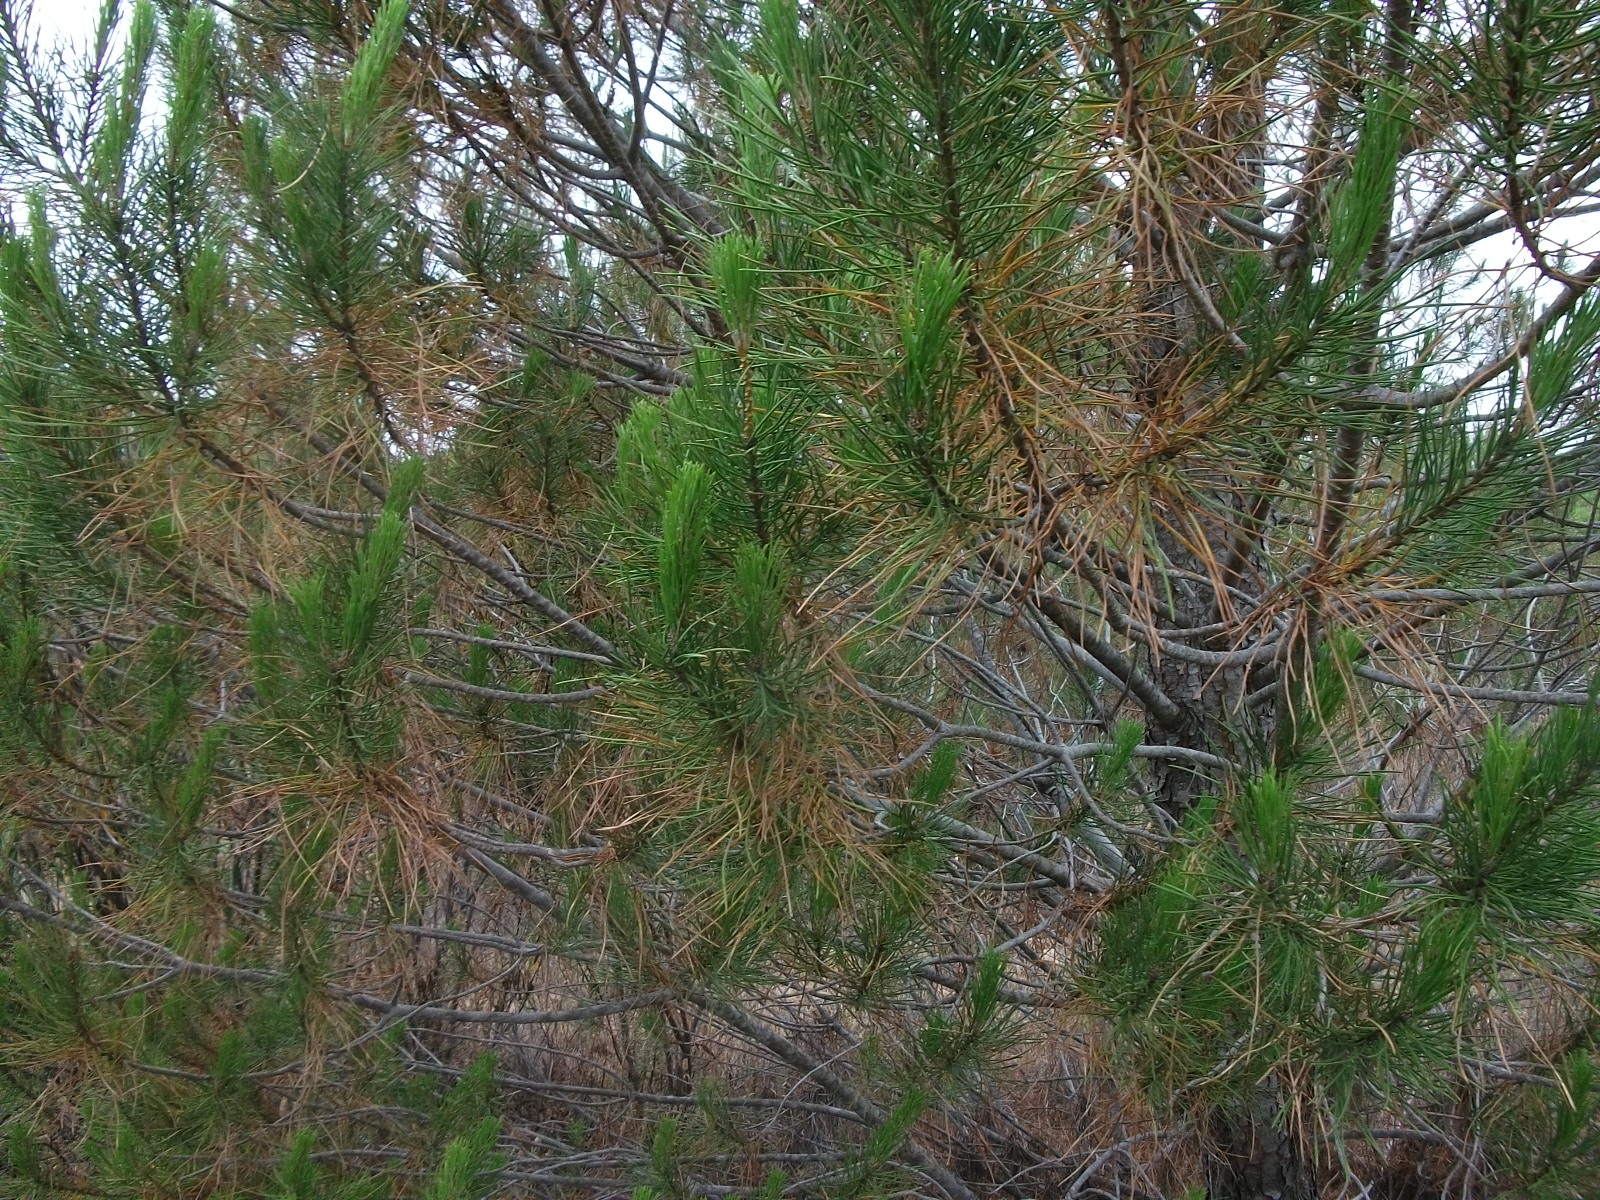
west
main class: Woodland
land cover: Pine dominated coniferous woodland
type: coniferous forest of the mediterranean region
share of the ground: 50 - 75 %
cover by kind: coniferous forest trees 60 %, shrubs 30 %, herbaceous plants 10 %
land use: Forestry
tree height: < 5 m
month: June
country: ES
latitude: 37.4610
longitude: -6.8981
